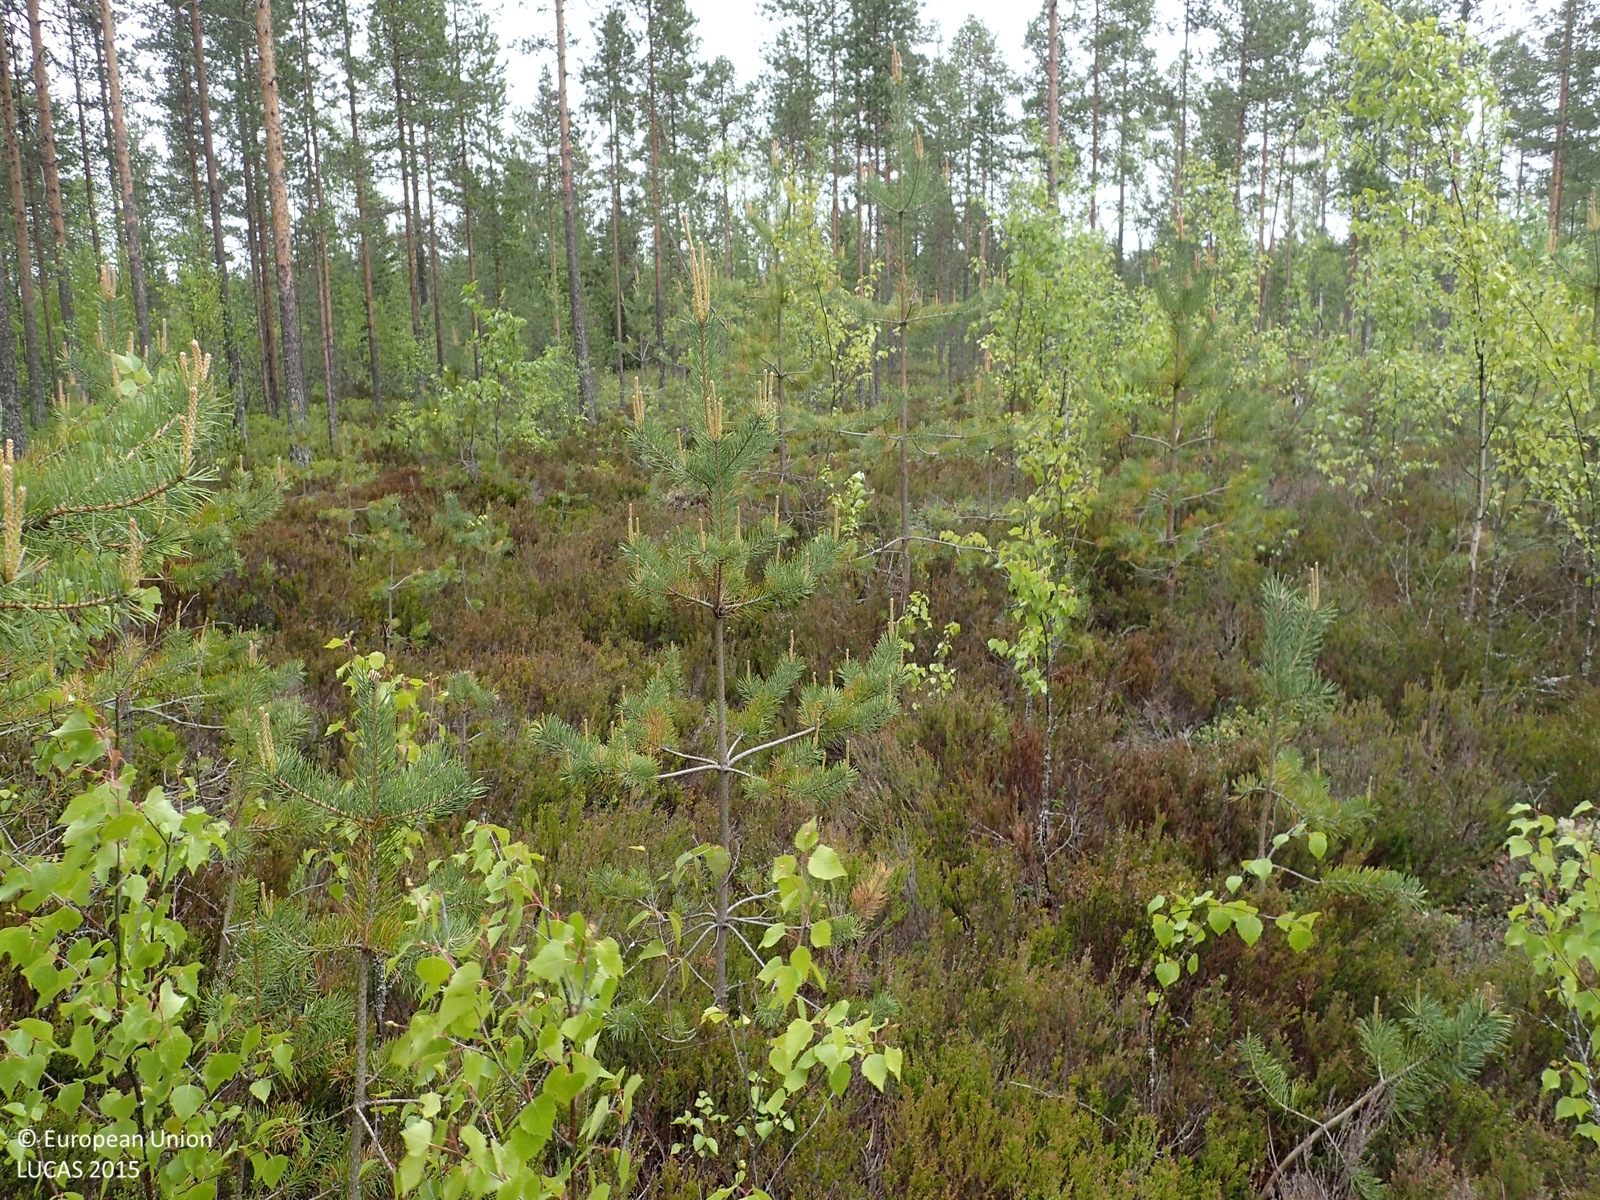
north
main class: Woodland
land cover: Broadleaved woodland
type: boreal forest
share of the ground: 25 - 50 %
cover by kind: shrubs 70 %, broadleaved forest trees 25 %, coniferous forest trees 5 %
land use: Forestry
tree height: < 5 m
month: June
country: FI
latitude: 62.4775
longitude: 22.4505
